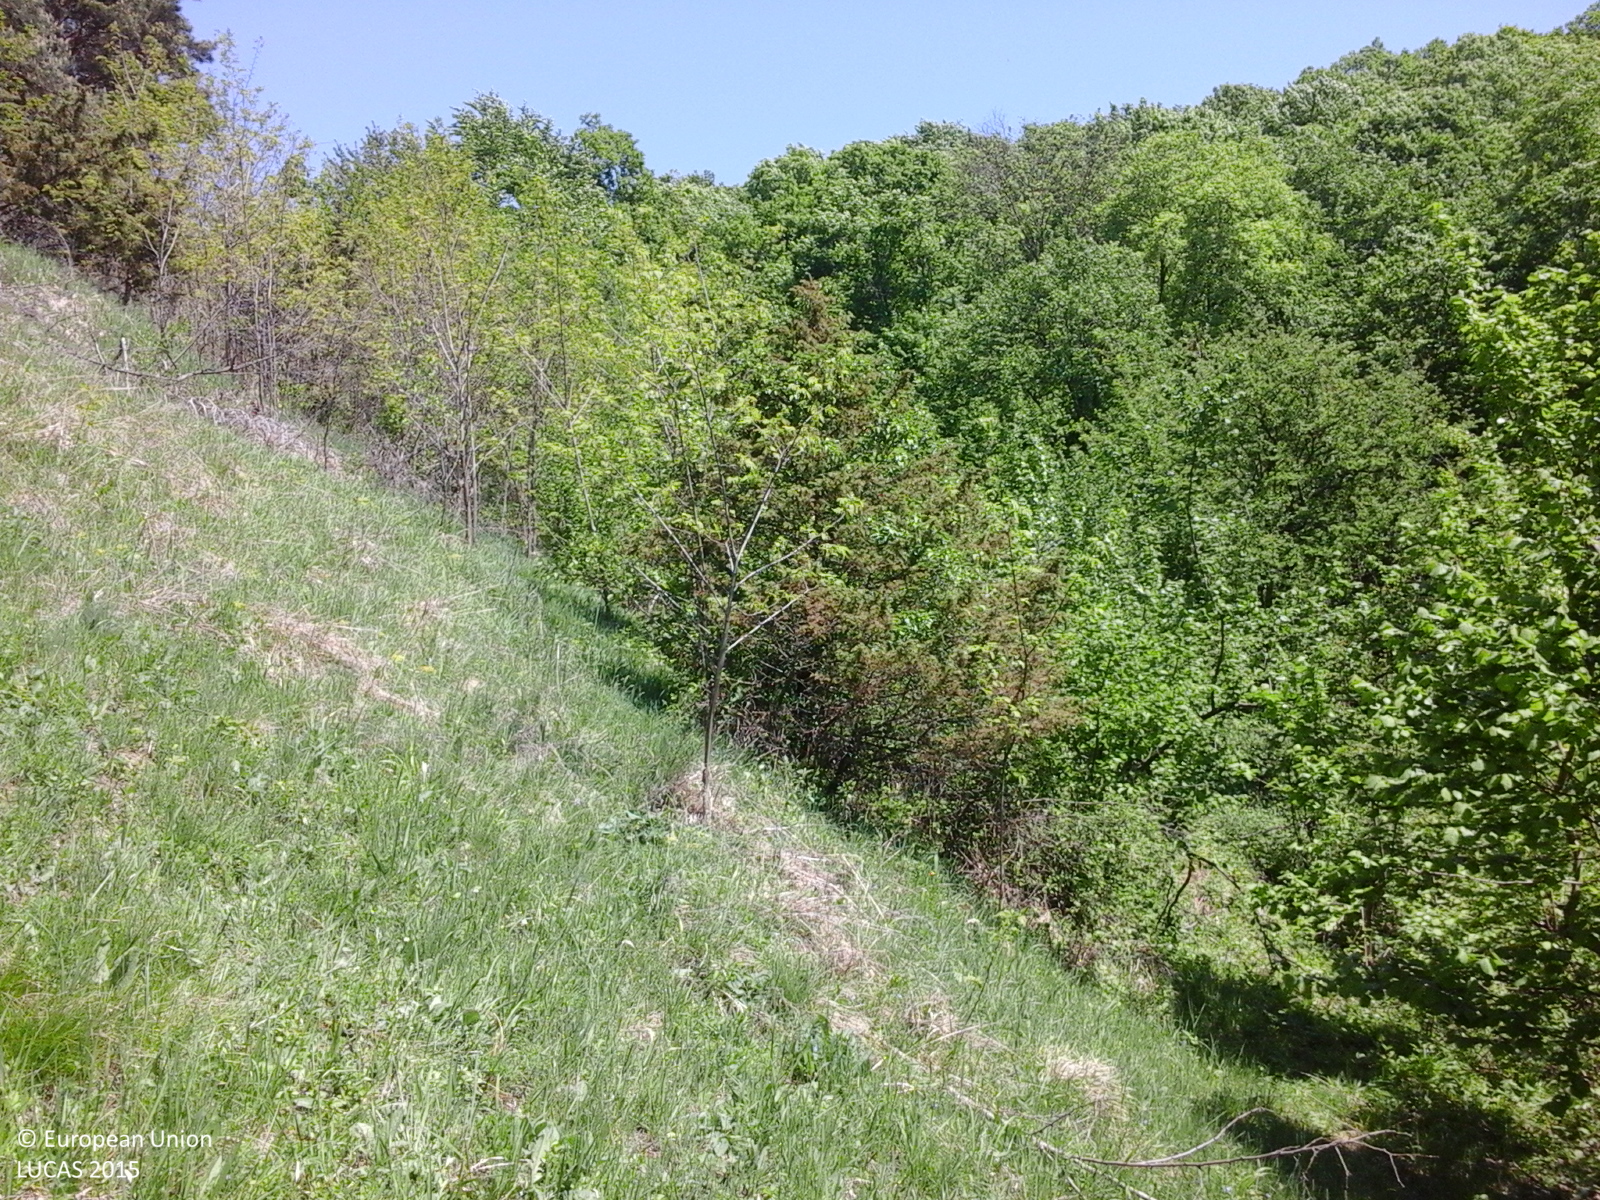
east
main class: Grassland
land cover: Grassland with sparse tree/shrub cover
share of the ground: > 75 %
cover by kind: herbaceous plants 85 %, shrubs 10 %, broadleaved forest trees 5 %
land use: Forestry
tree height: > 5 m
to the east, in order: Grassland with sparse tree/shrub cover; Broadleaved woodland; Tracks; Broadleaved woodland
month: May
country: RO
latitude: 45.8112
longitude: 25.6657
